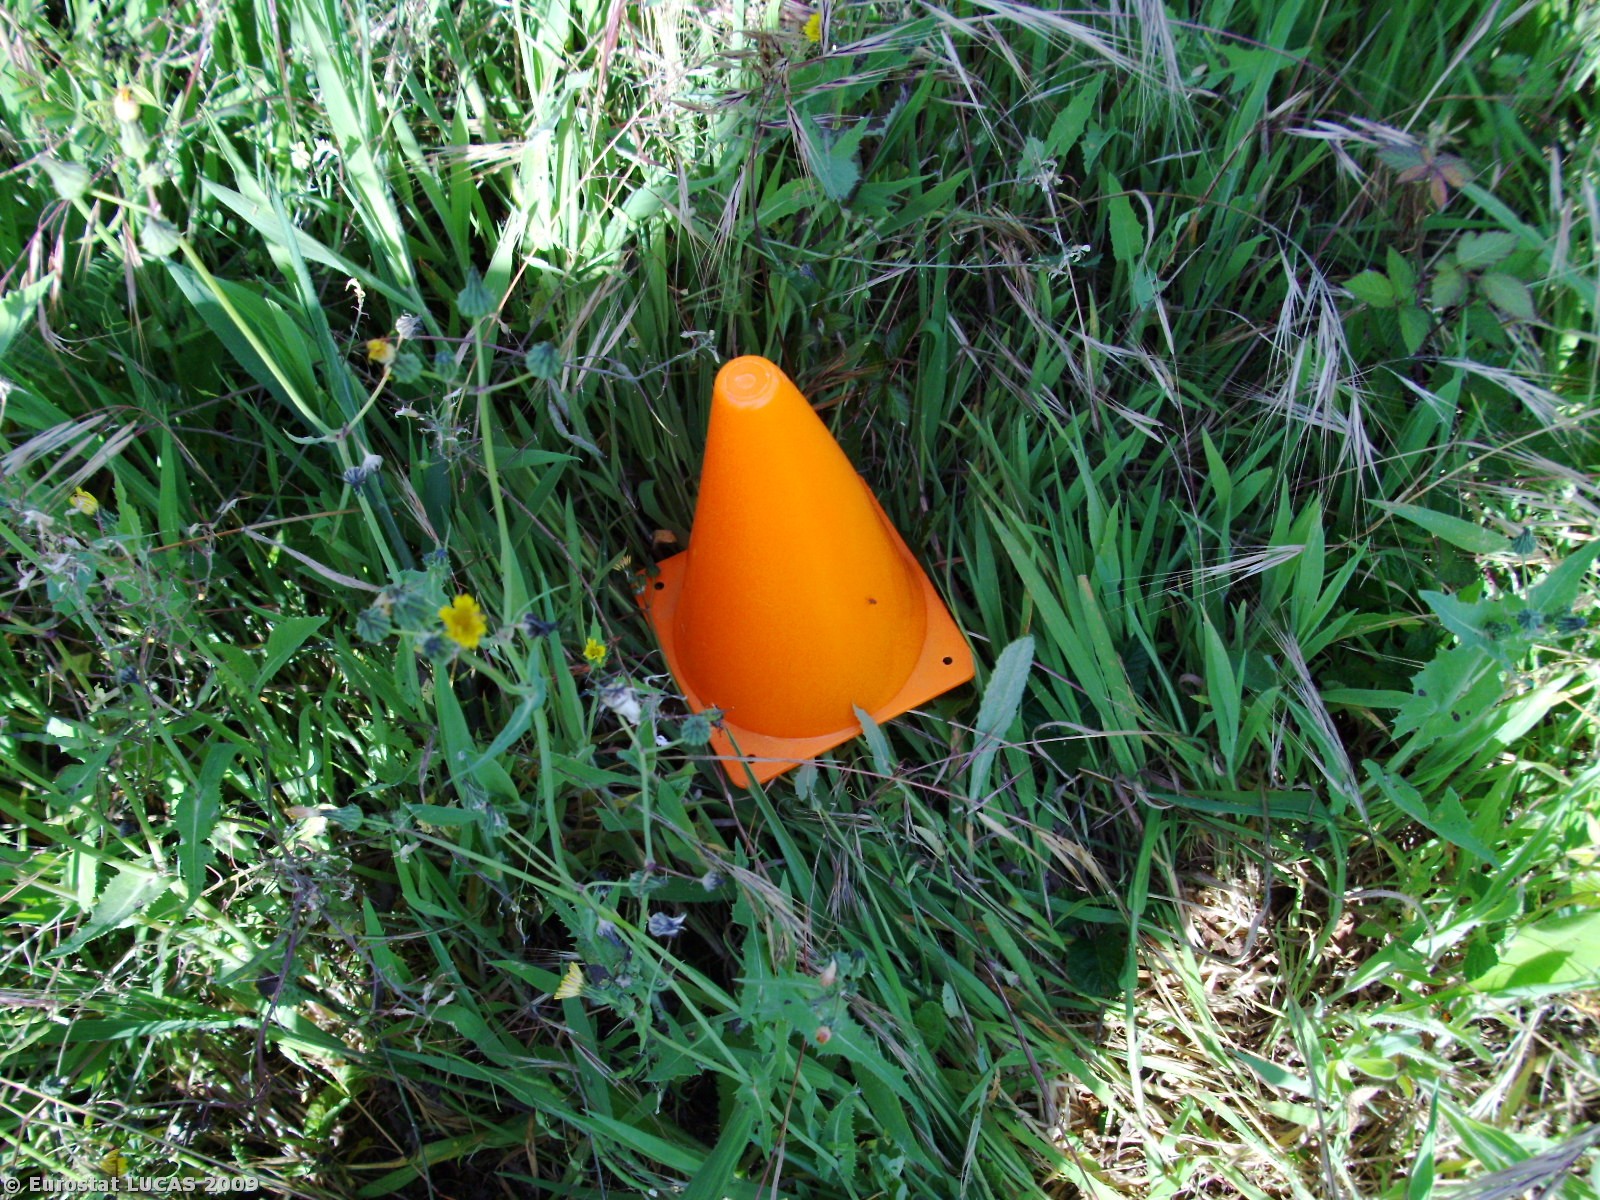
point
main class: Woodland
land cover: Broadleaved woodland
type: plantations and self-sown exotic forest
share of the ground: 25 - 50 %
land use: Forestry
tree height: > 5 m
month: May
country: PT
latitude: 40.8893
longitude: -8.5303
